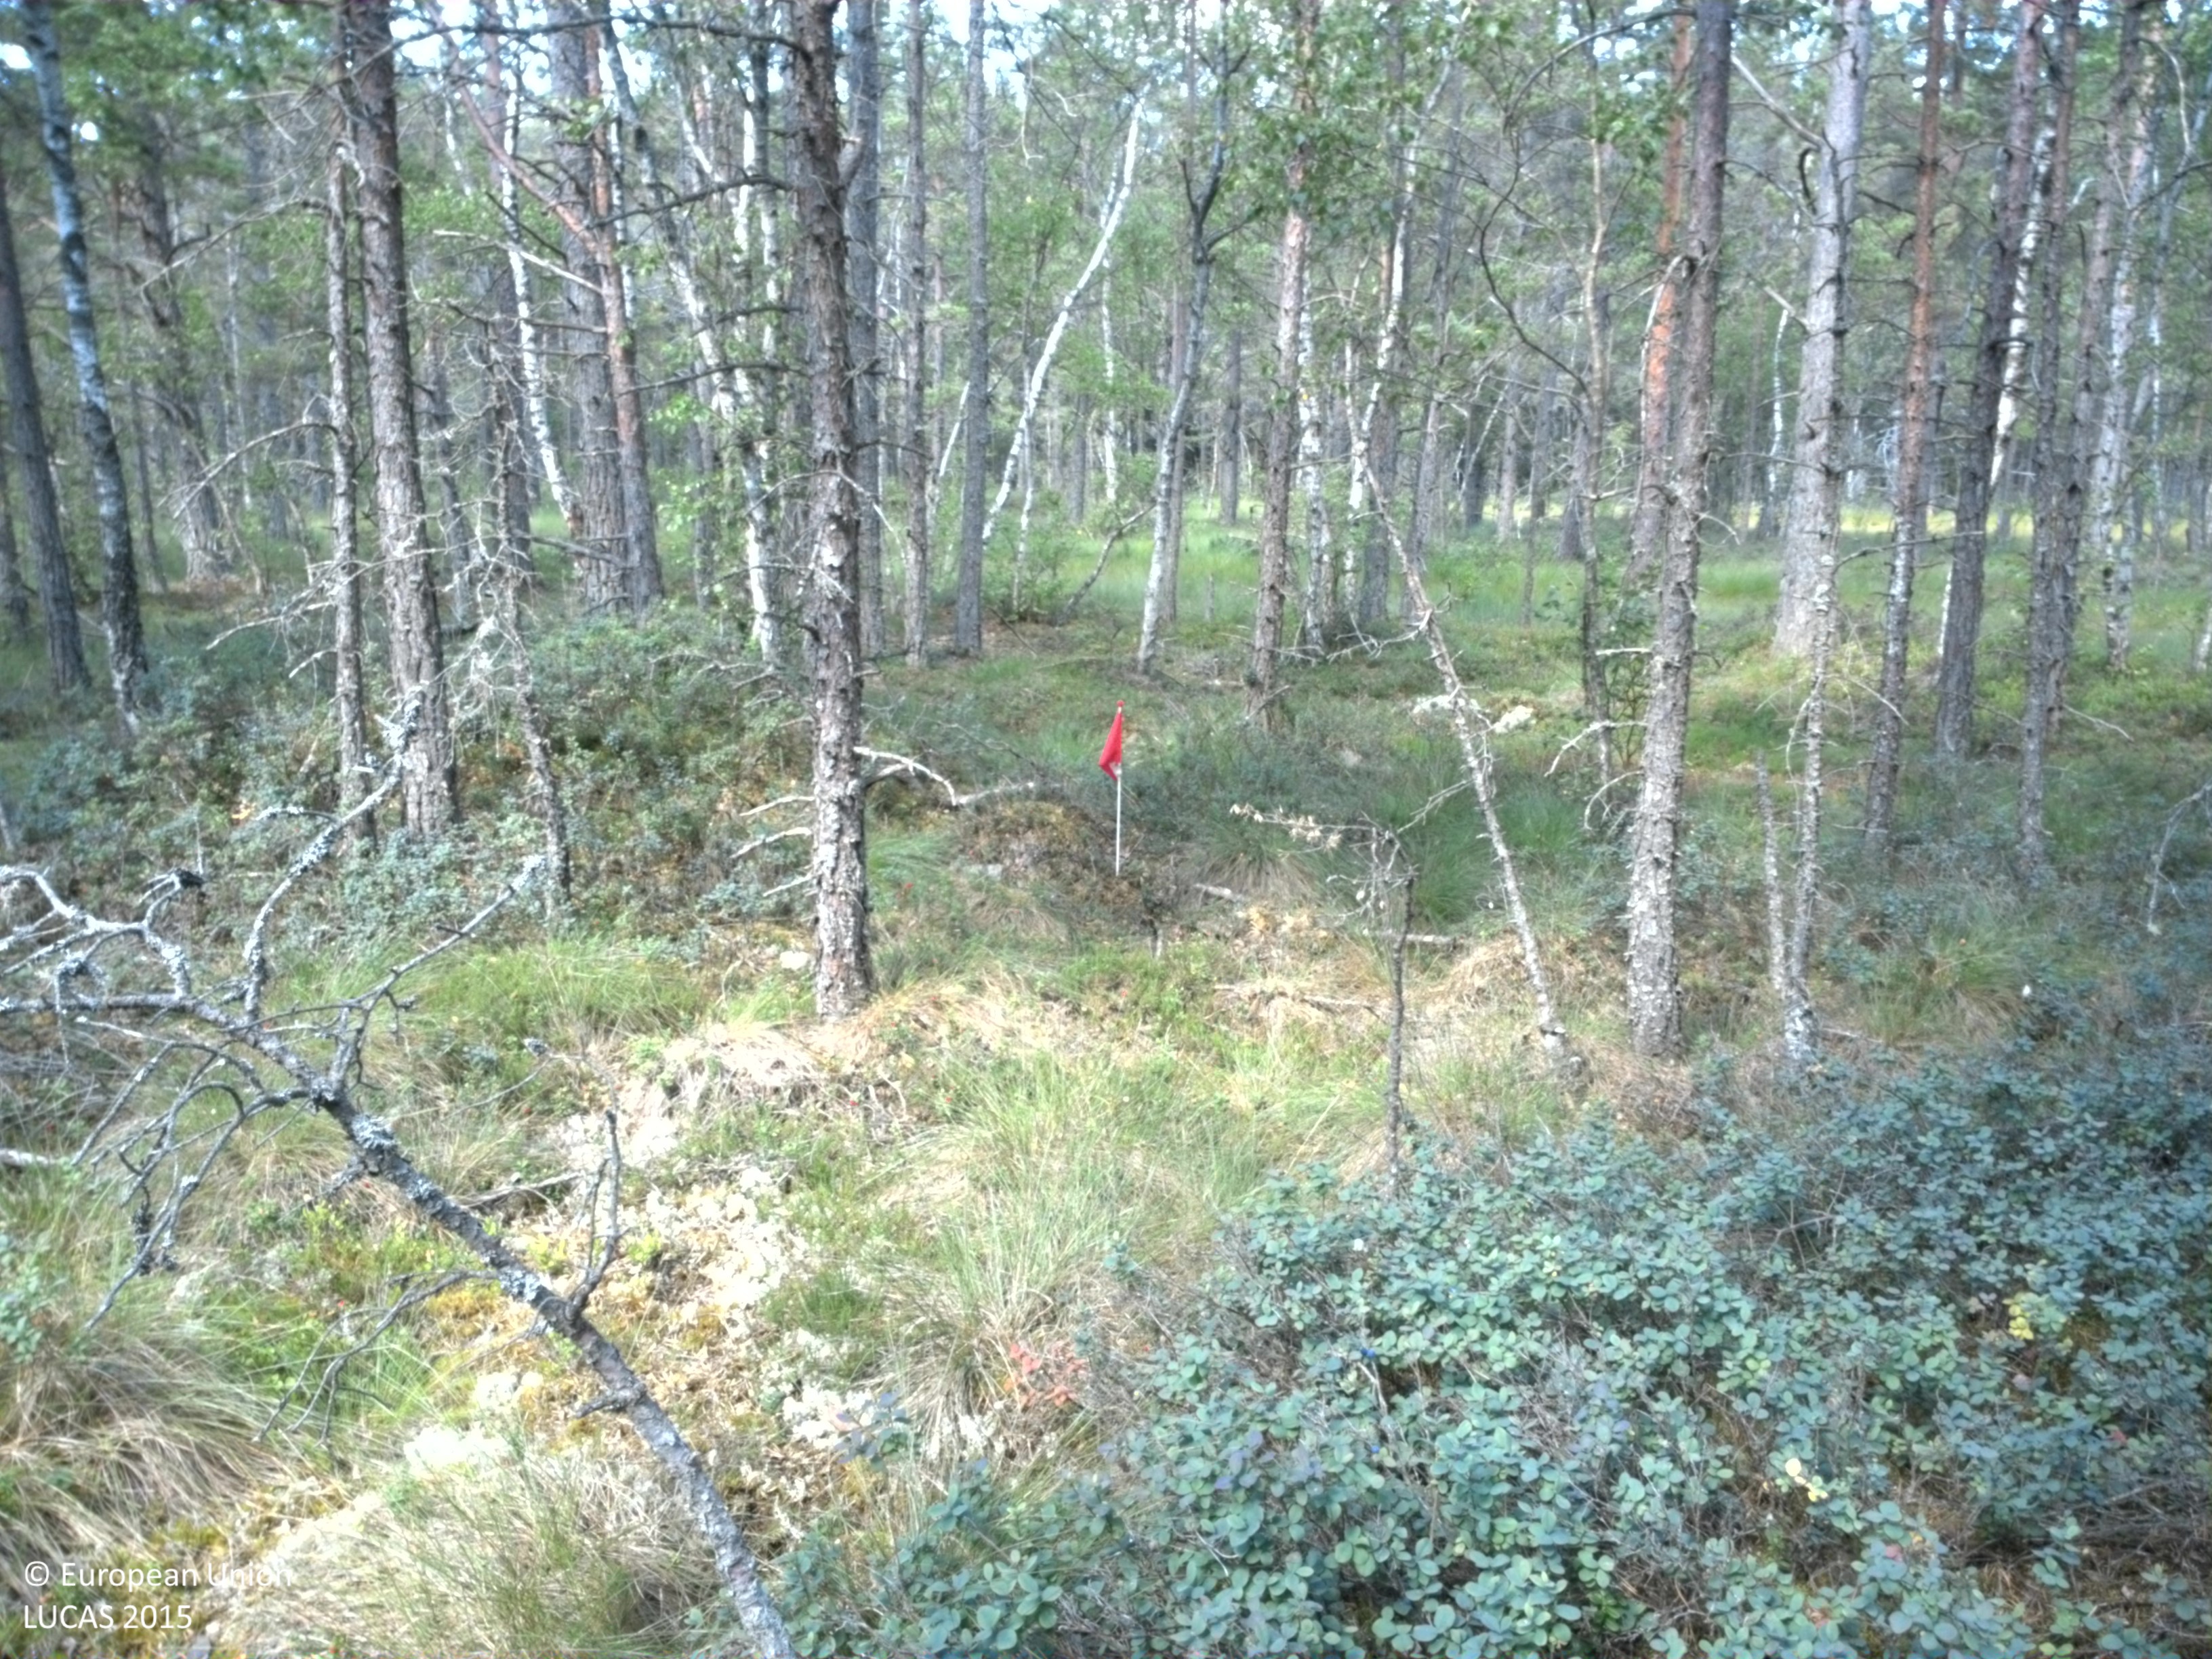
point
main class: Woodland
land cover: Pine dominated mixed woodland
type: boreal forest
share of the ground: 25 - 50 %
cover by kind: coniferous forest trees 30 %, shrubs 30 %, broadleaved forest trees 20 %, lichens and mosses 15 %, herbaceous plants 5 %
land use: Semi-natural and natural areas not in use
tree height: > 5 m
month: August
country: SE
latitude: 58.2163
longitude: 13.2458
